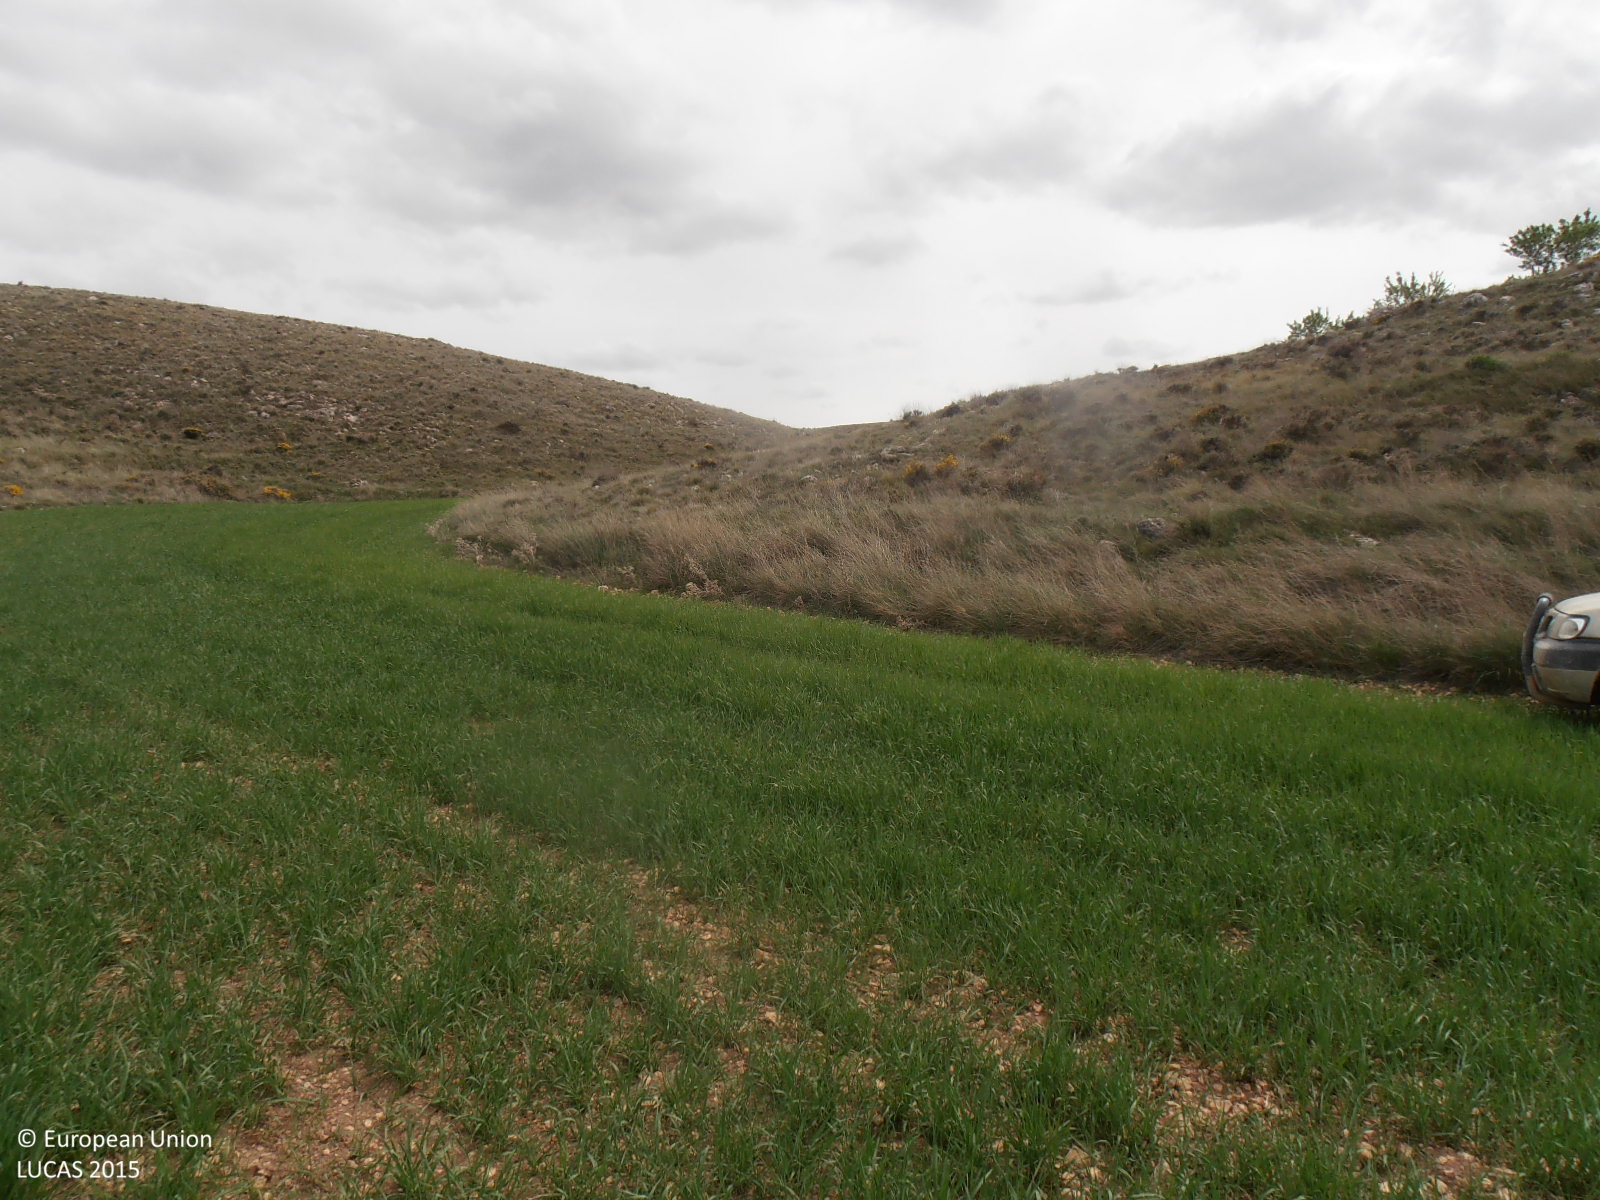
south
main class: Shrubland
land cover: Shrubland without tree cover
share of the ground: > 75 %
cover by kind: shrubs 60 %, consolidated bare surface 30 %, herbaceous plants 10 %
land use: Semi-natural and natural areas not in use
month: April
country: ES
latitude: 41.0948
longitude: -0.9343
